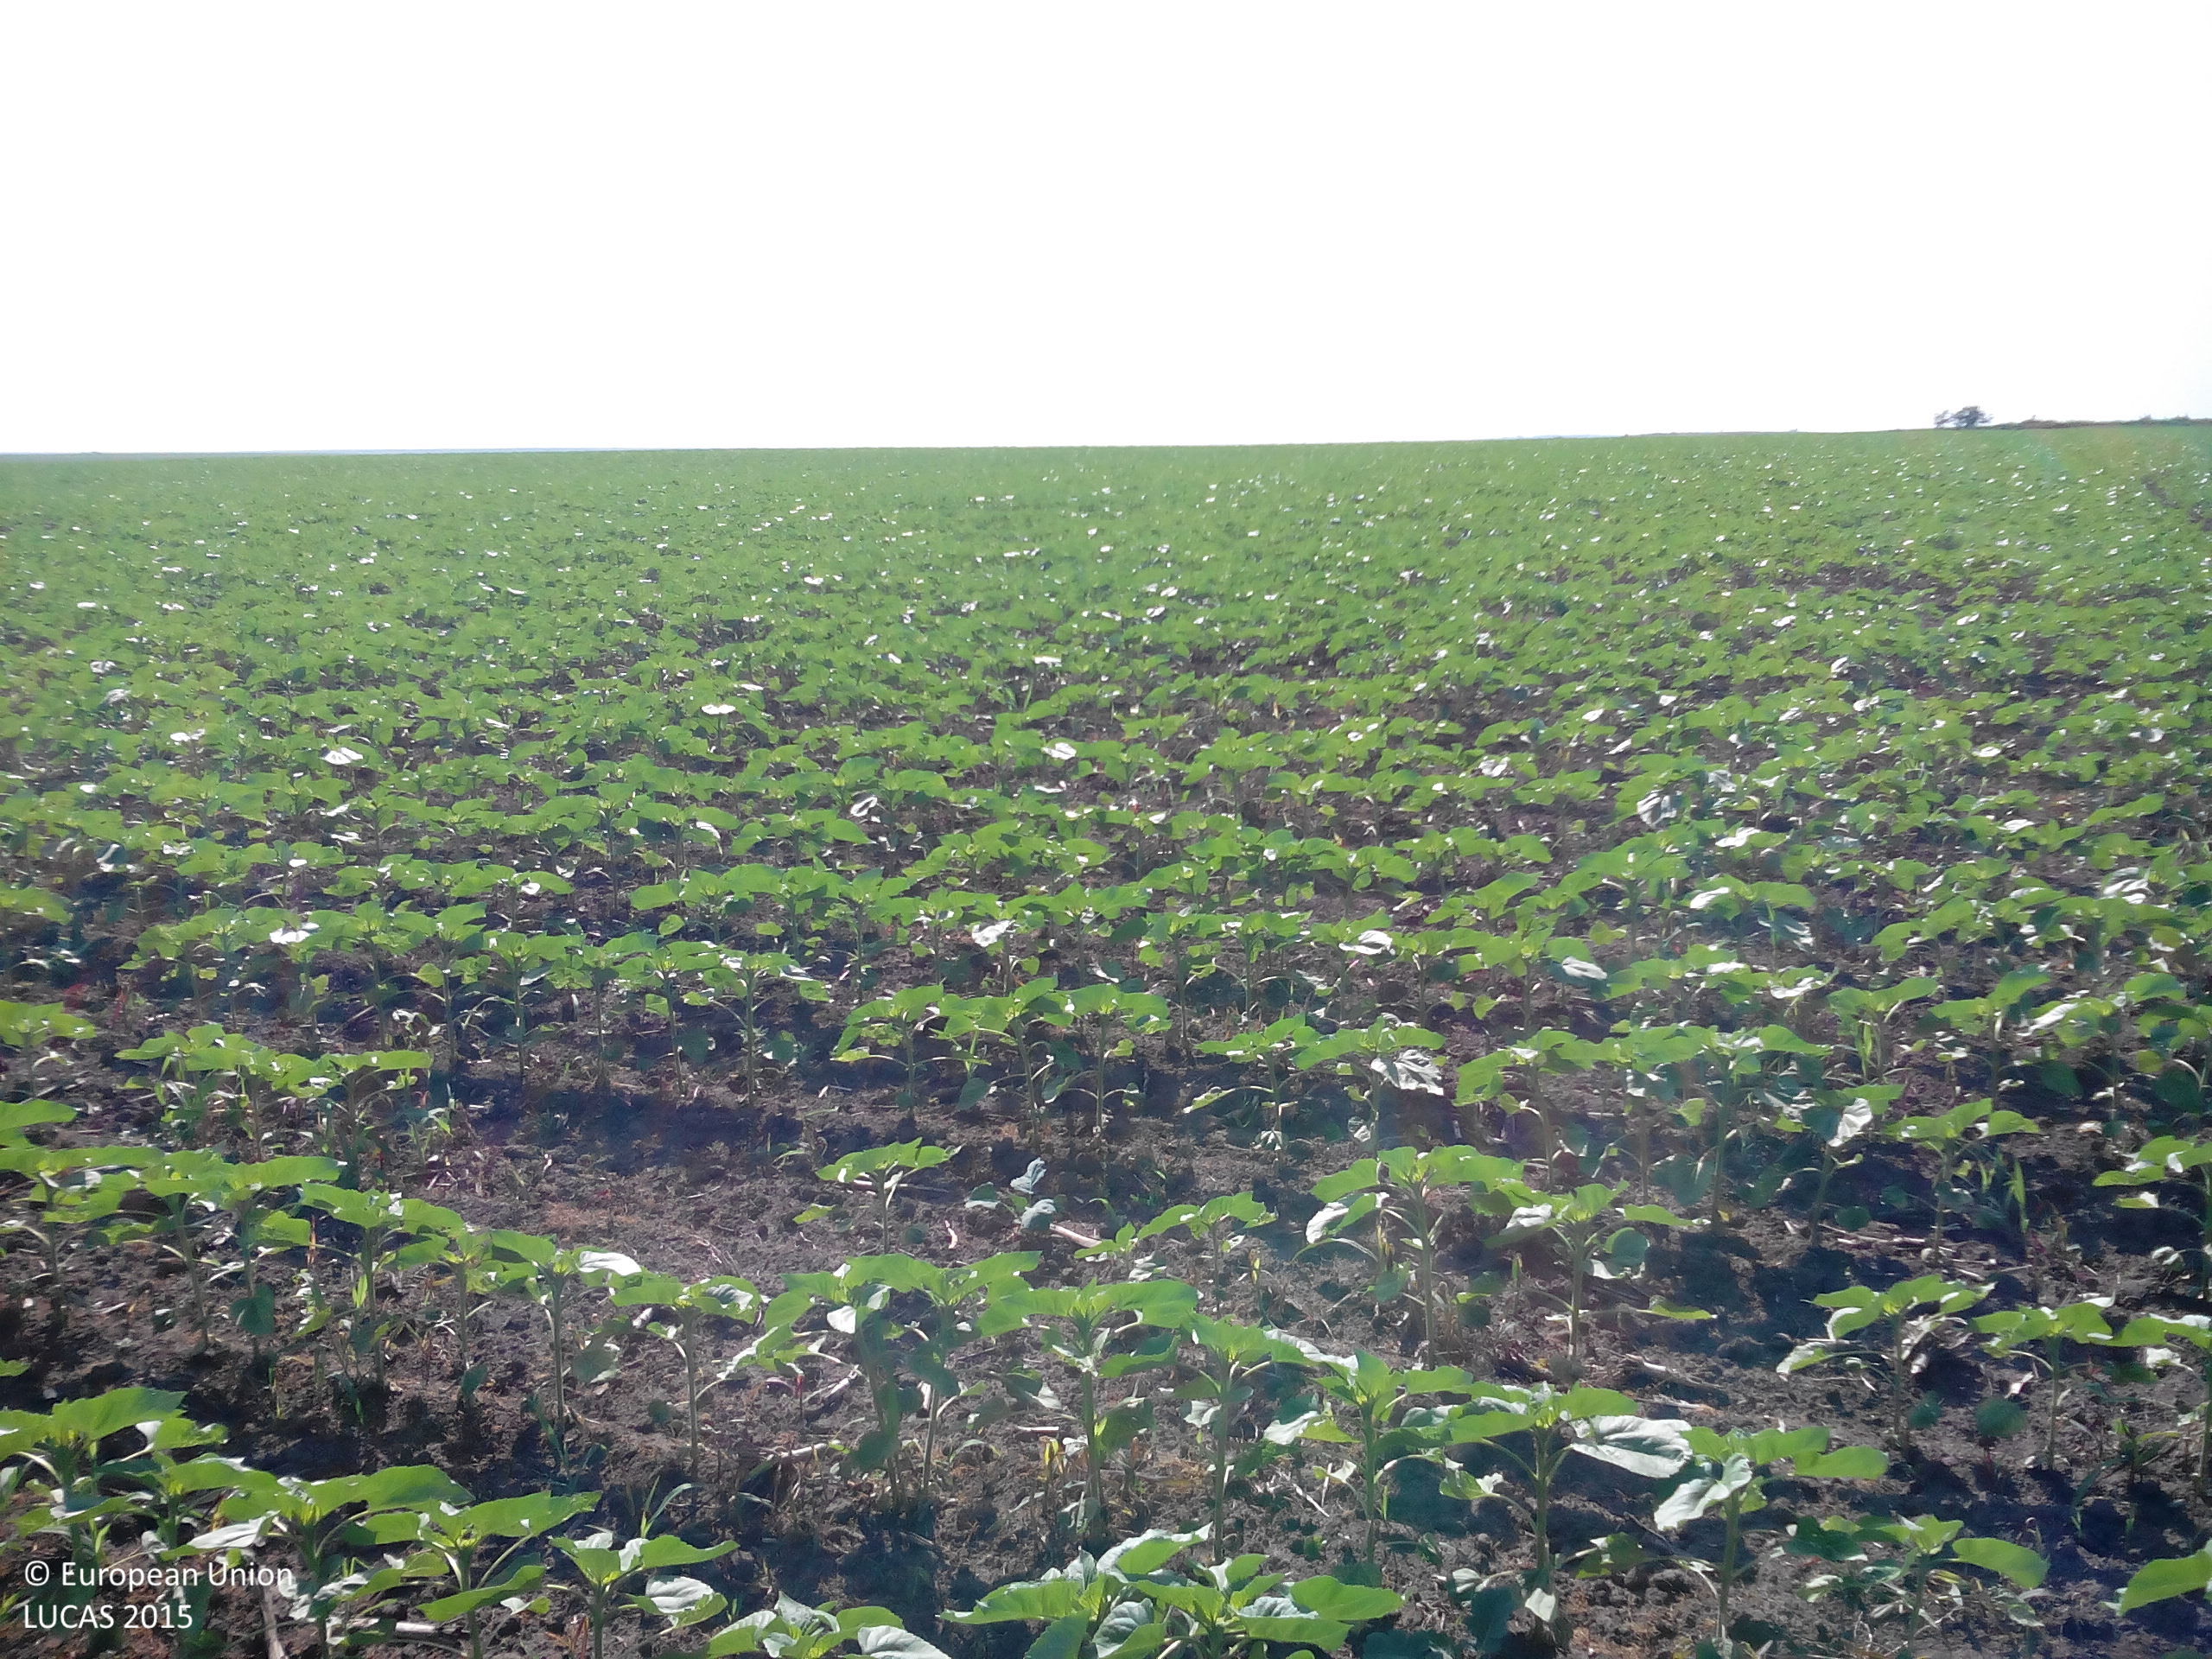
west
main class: Cropland
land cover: Sunflower
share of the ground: 50 - 75 %
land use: Agriculture (excluding fallow land and kitchen gardens)
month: May
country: BG
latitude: 43.6498
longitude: 24.2798
